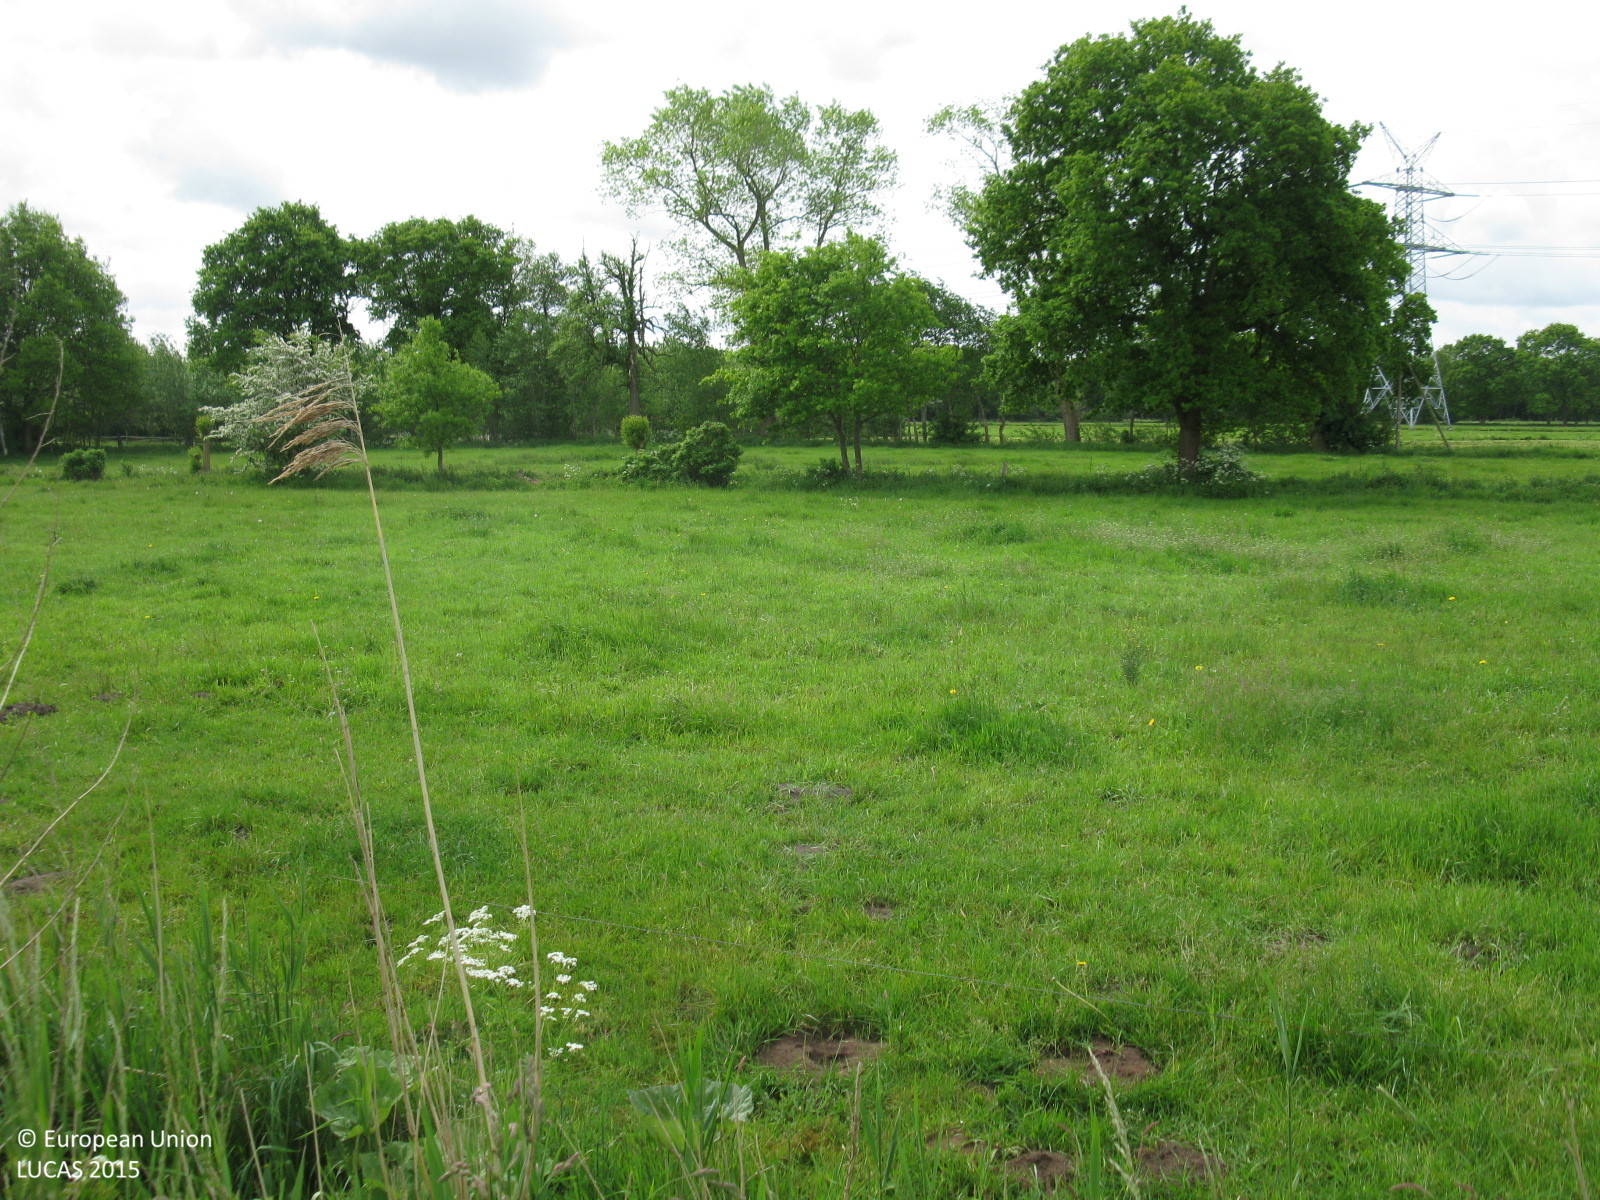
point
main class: Grassland
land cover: Grassland without tree/shrub cover
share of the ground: > 75 %
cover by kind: herbaceous plants 100 %
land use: Agriculture (excluding fallow land and kitchen gardens)
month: June
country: DE
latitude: 53.1380
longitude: 7.2949
